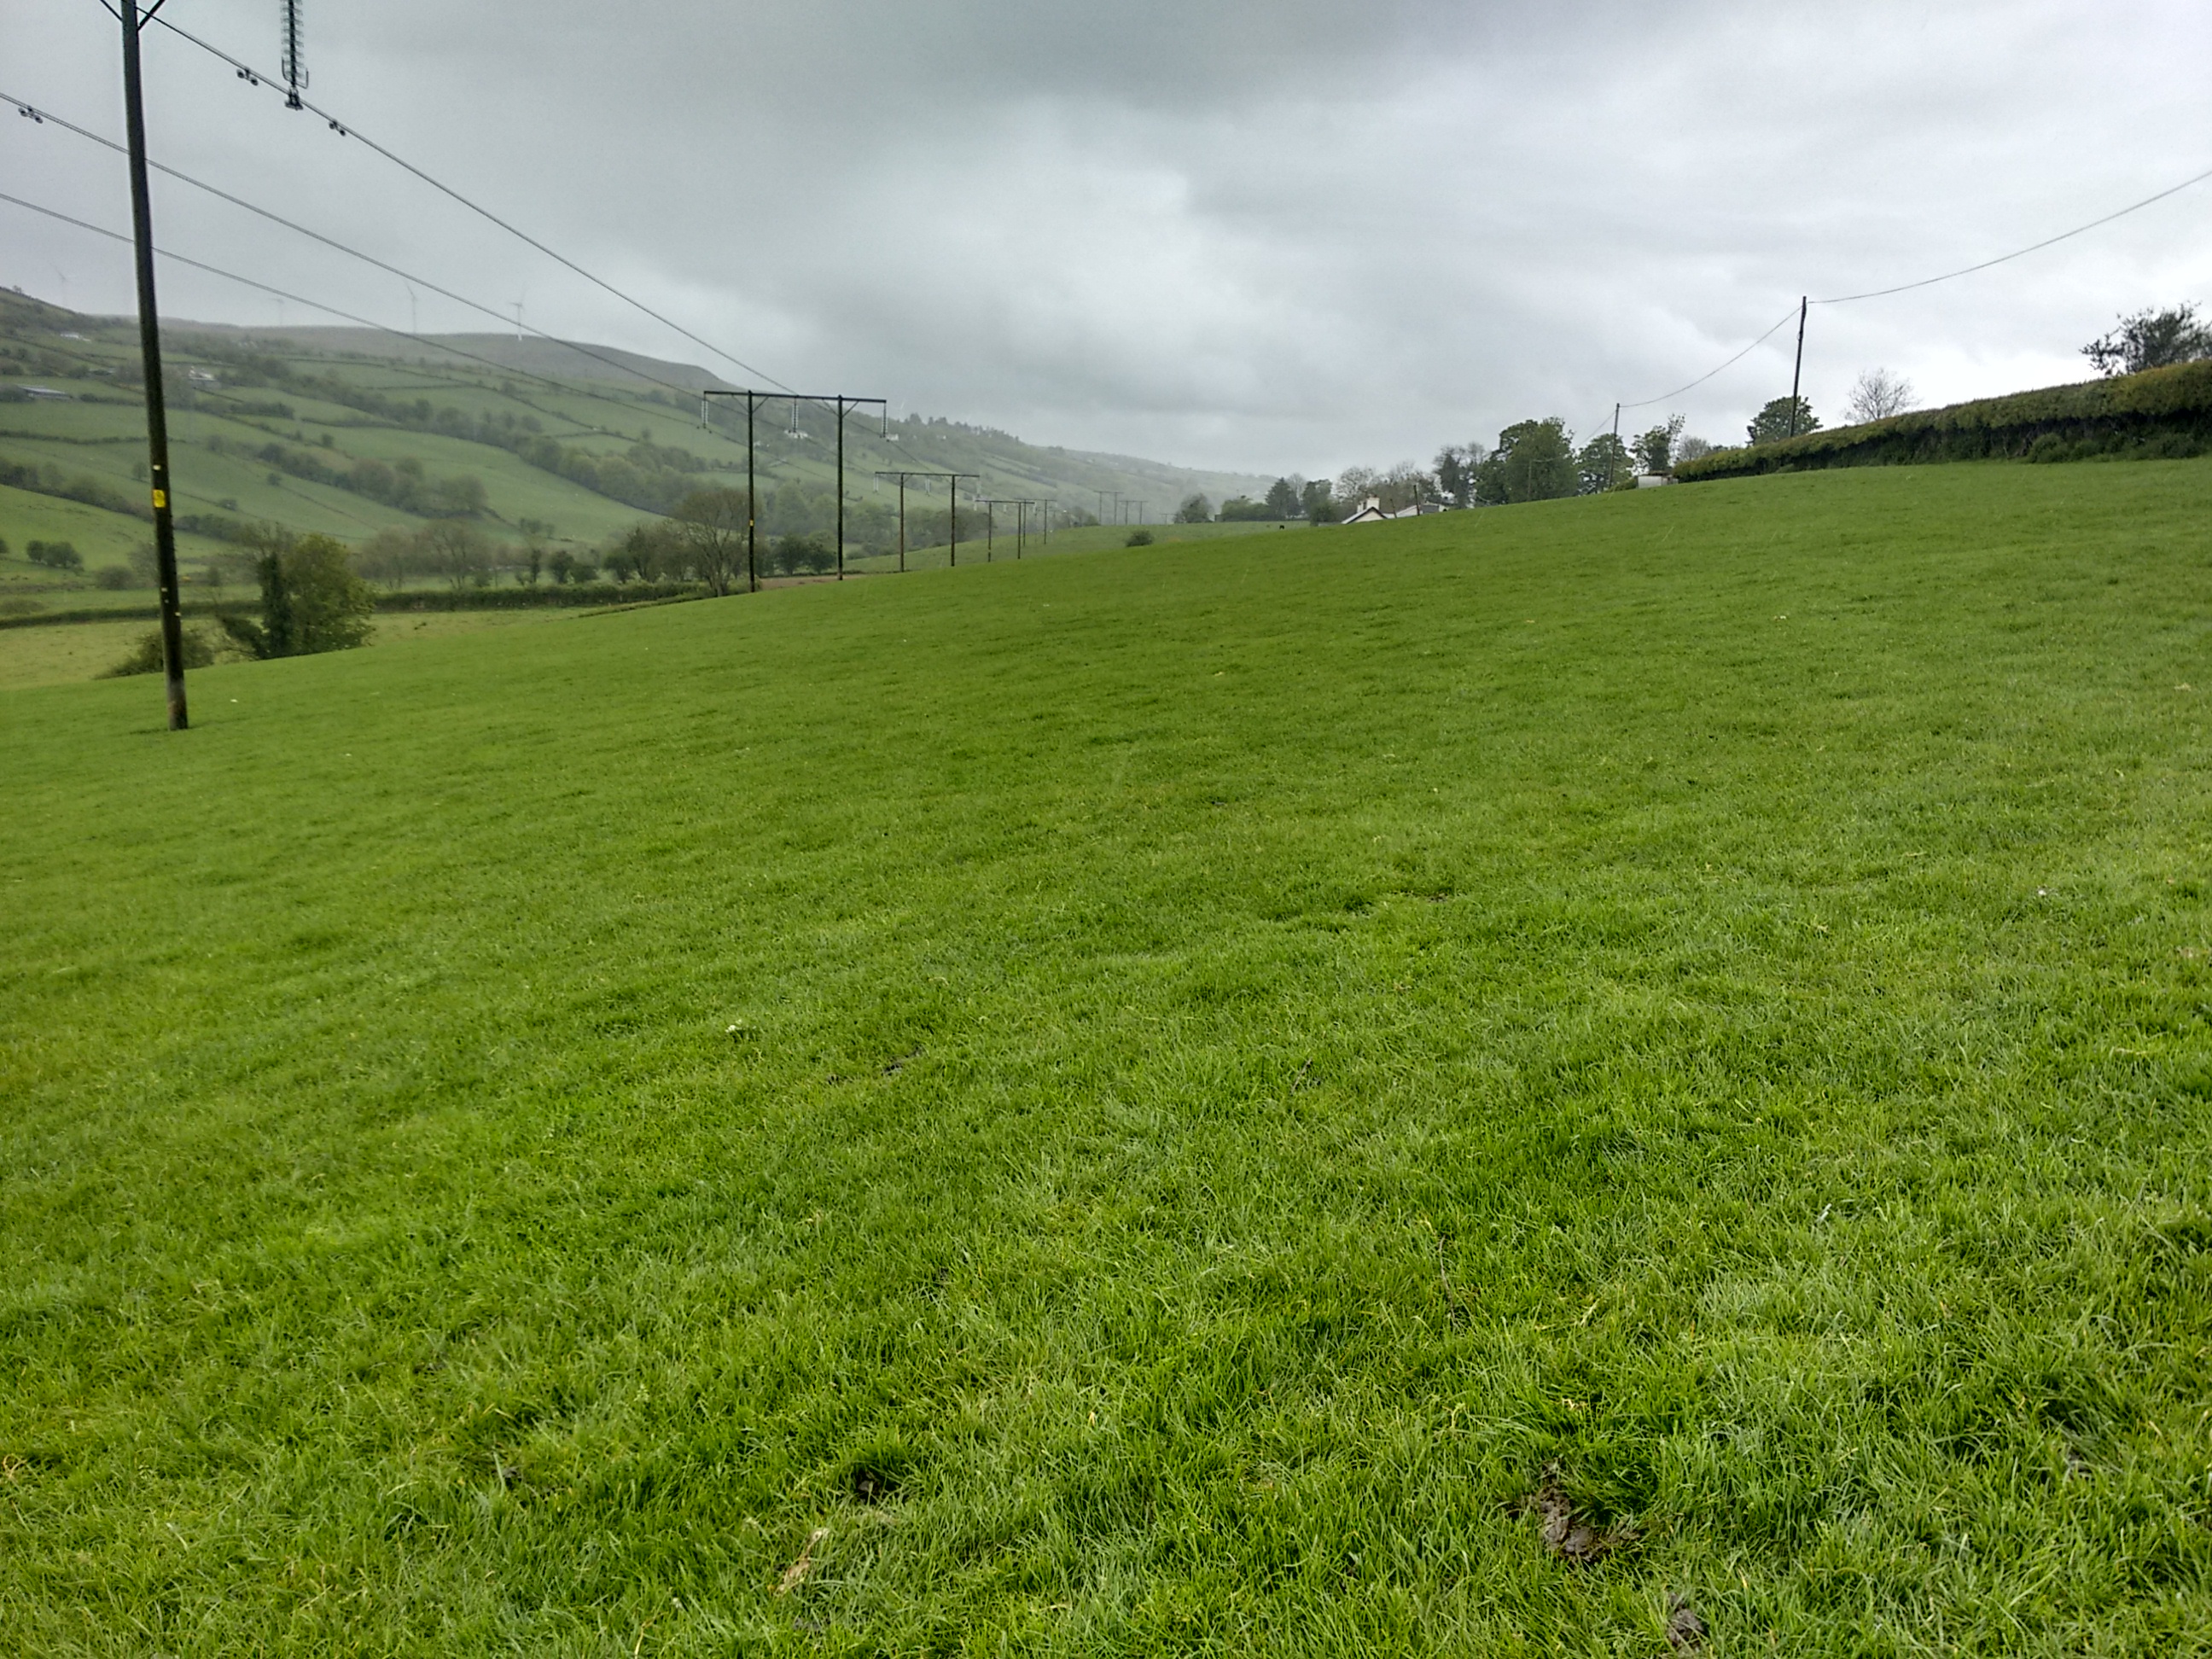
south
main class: Grassland
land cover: Grassland without tree/shrub cover
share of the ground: > 75 %
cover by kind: herbaceous plants 100 %
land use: Agriculture (excluding fallow land and kitchen gardens)
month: May
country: GB
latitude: 54.9601
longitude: -7.3116
